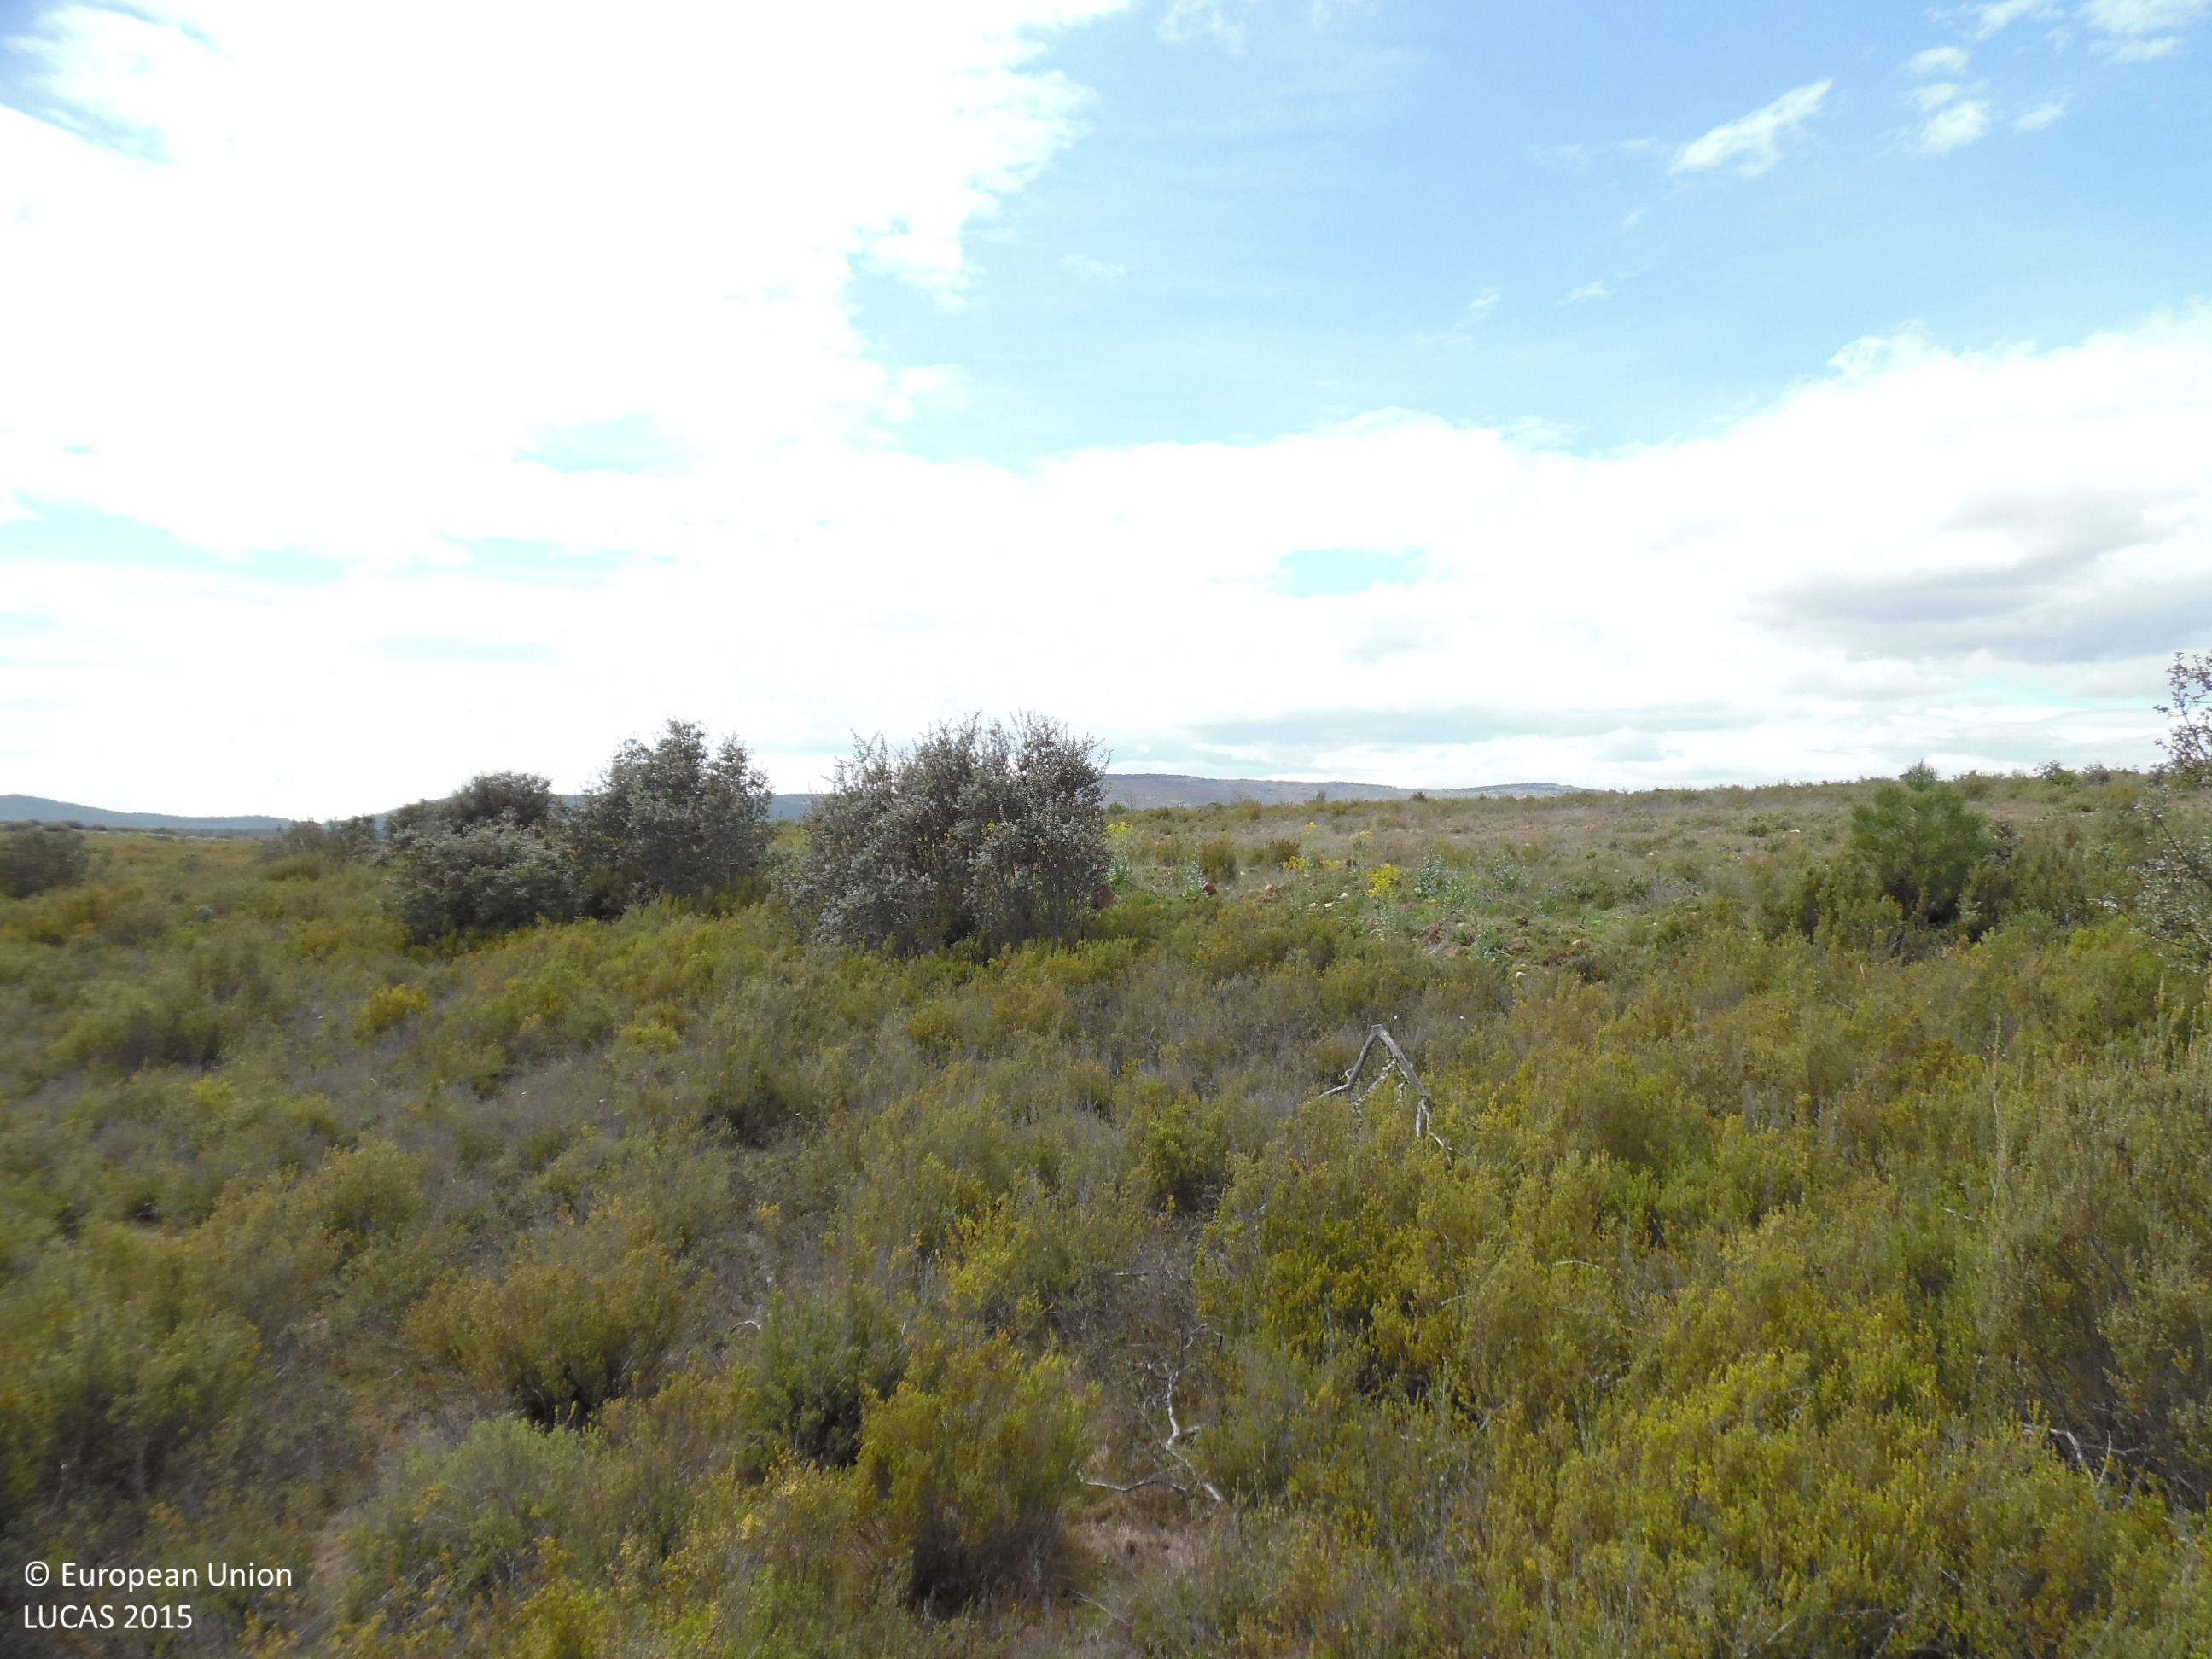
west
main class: Shrubland
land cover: Shrubland with sparse tree cover
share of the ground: > 75 %
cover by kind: shrubs 95 %, broadleaved forest trees 5 %
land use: Semi-natural and natural areas not in use
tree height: < 5 m
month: April
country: ES
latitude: 42.2265
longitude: -6.0595
